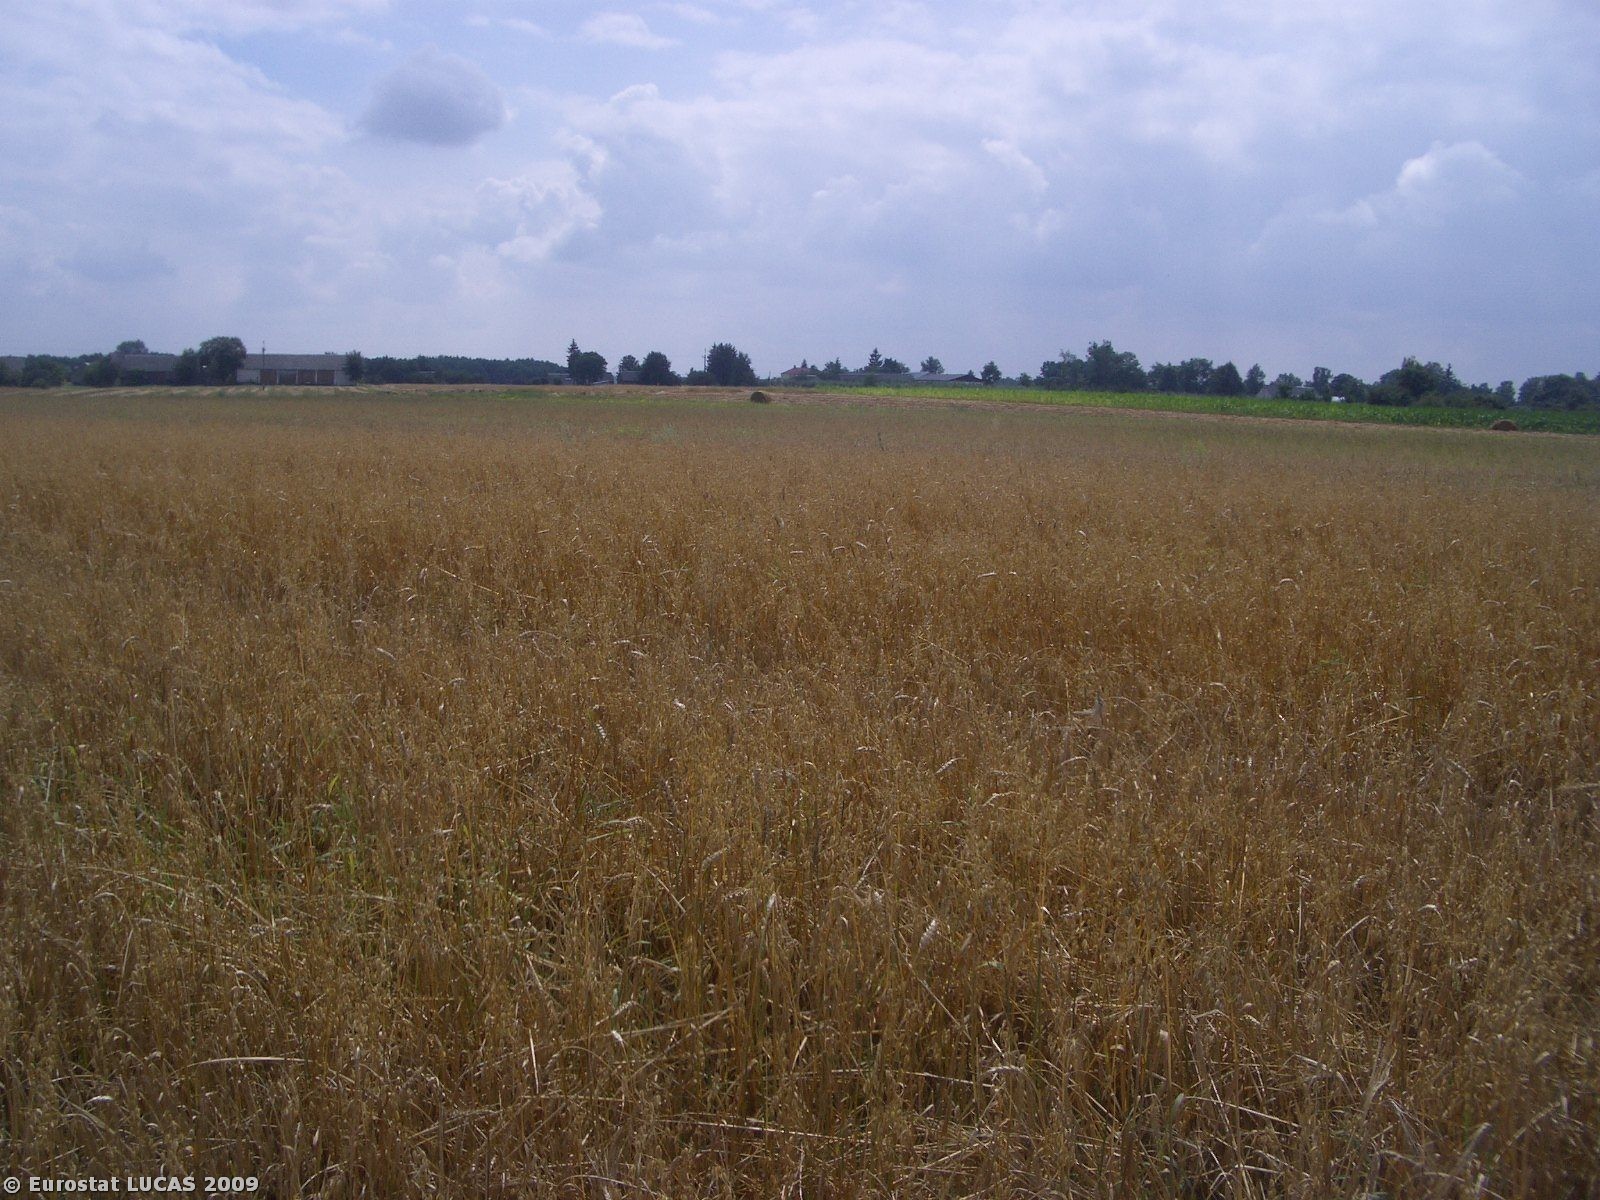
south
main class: Cropland
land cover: Oats
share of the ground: 50 - 75 %
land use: Agriculture (excluding fallow land and kitchen gardens)
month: August
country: PL
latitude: 51.7647
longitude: 23.1919
